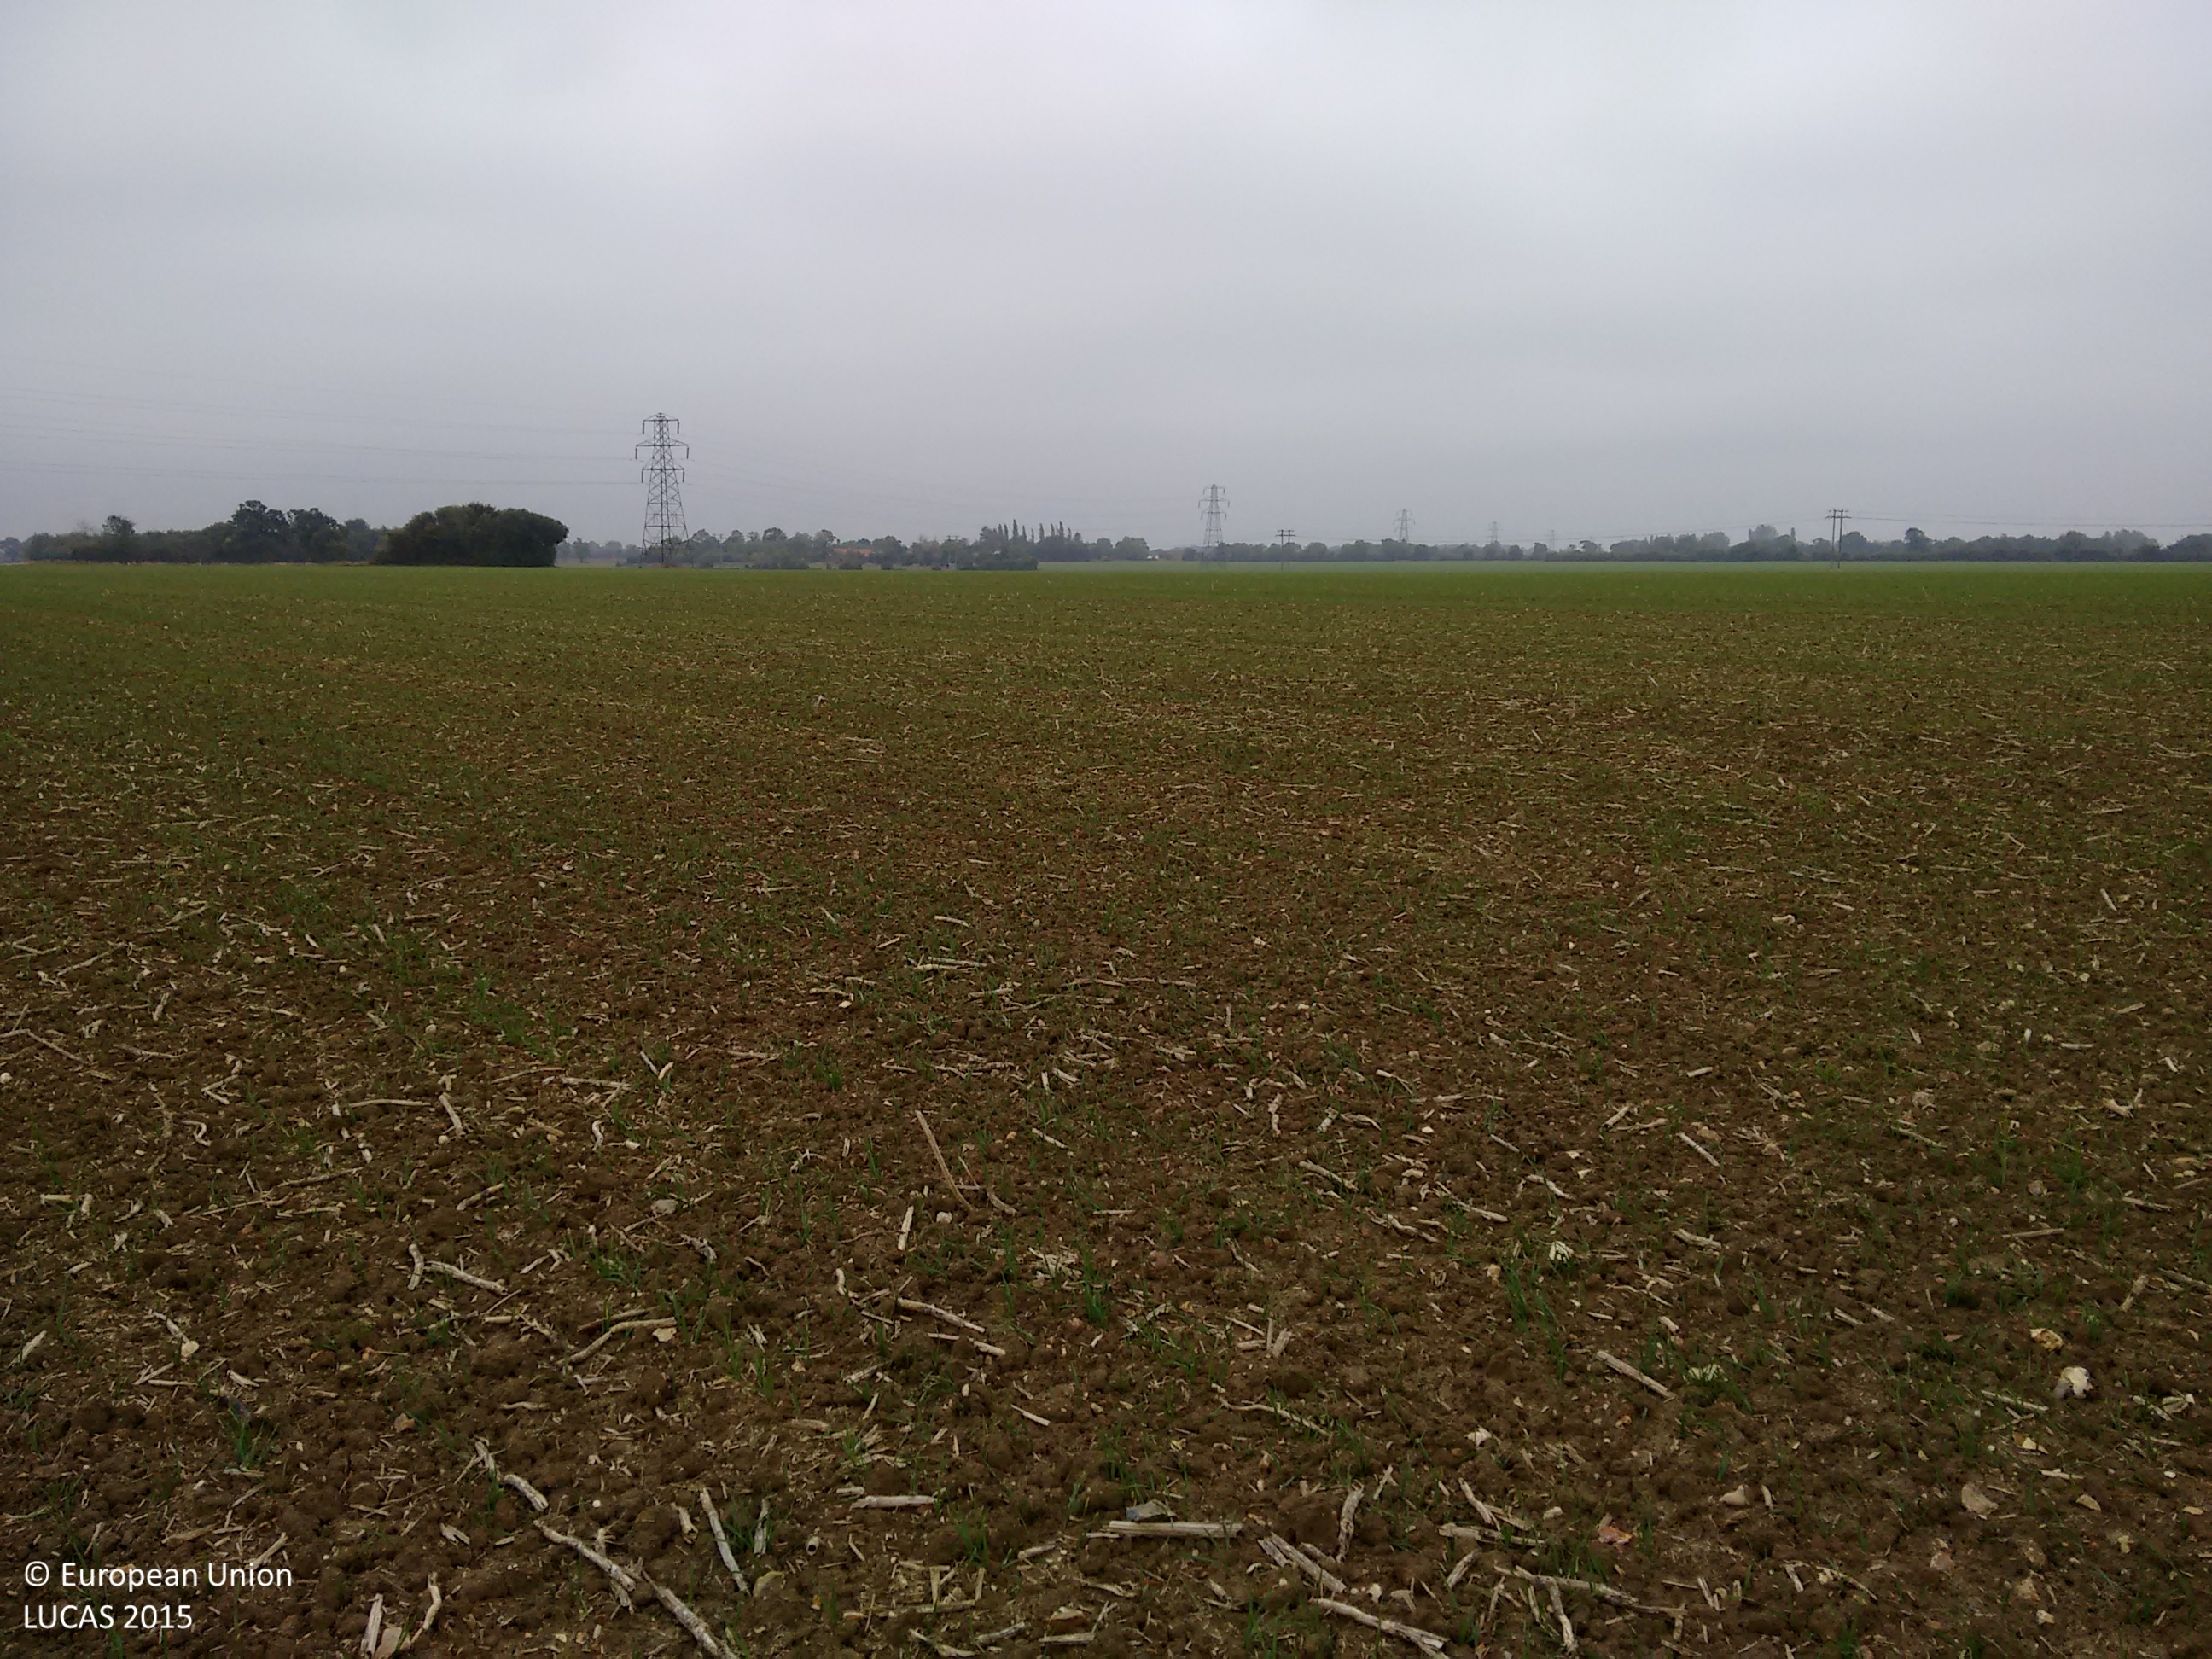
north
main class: Cropland
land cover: Common wheat
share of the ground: < 10 %
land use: Agriculture (excluding fallow land and kitchen gardens)
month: October
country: GB
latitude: 52.3956
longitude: 1.4717
